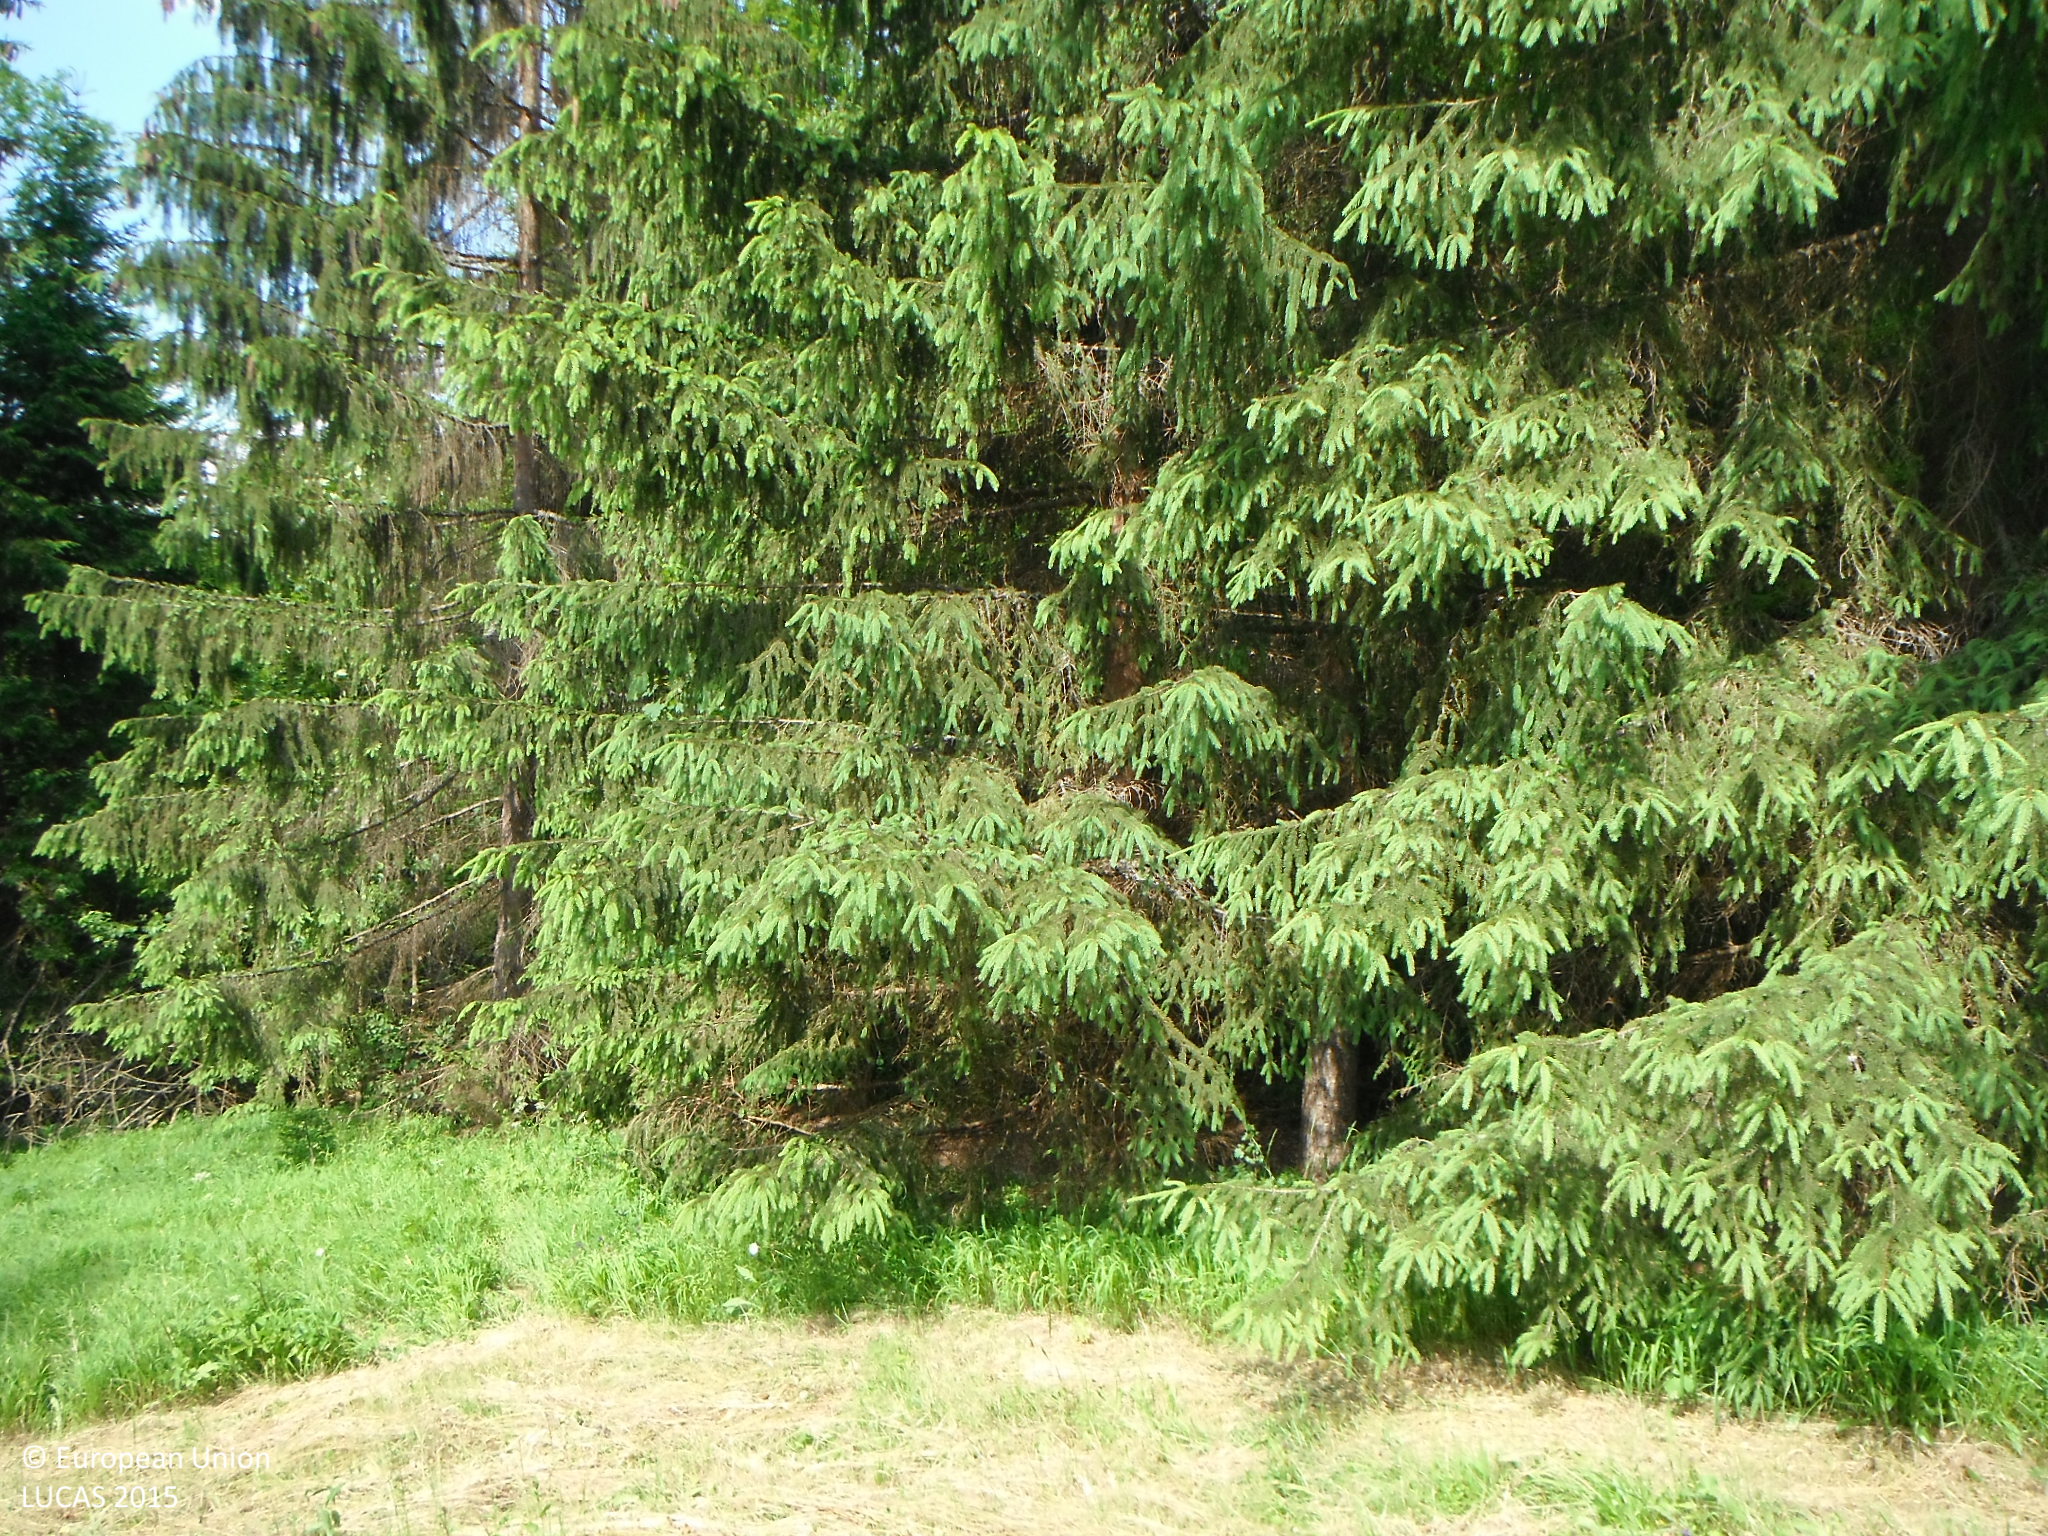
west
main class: Grassland
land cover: Grassland without tree/shrub cover
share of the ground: > 75 %
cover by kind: herbaceous plants 100 %
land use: Agriculture (excluding fallow land and kitchen gardens)
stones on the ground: < 10 %
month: June
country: SK
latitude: 49.2356
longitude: 19.3780
